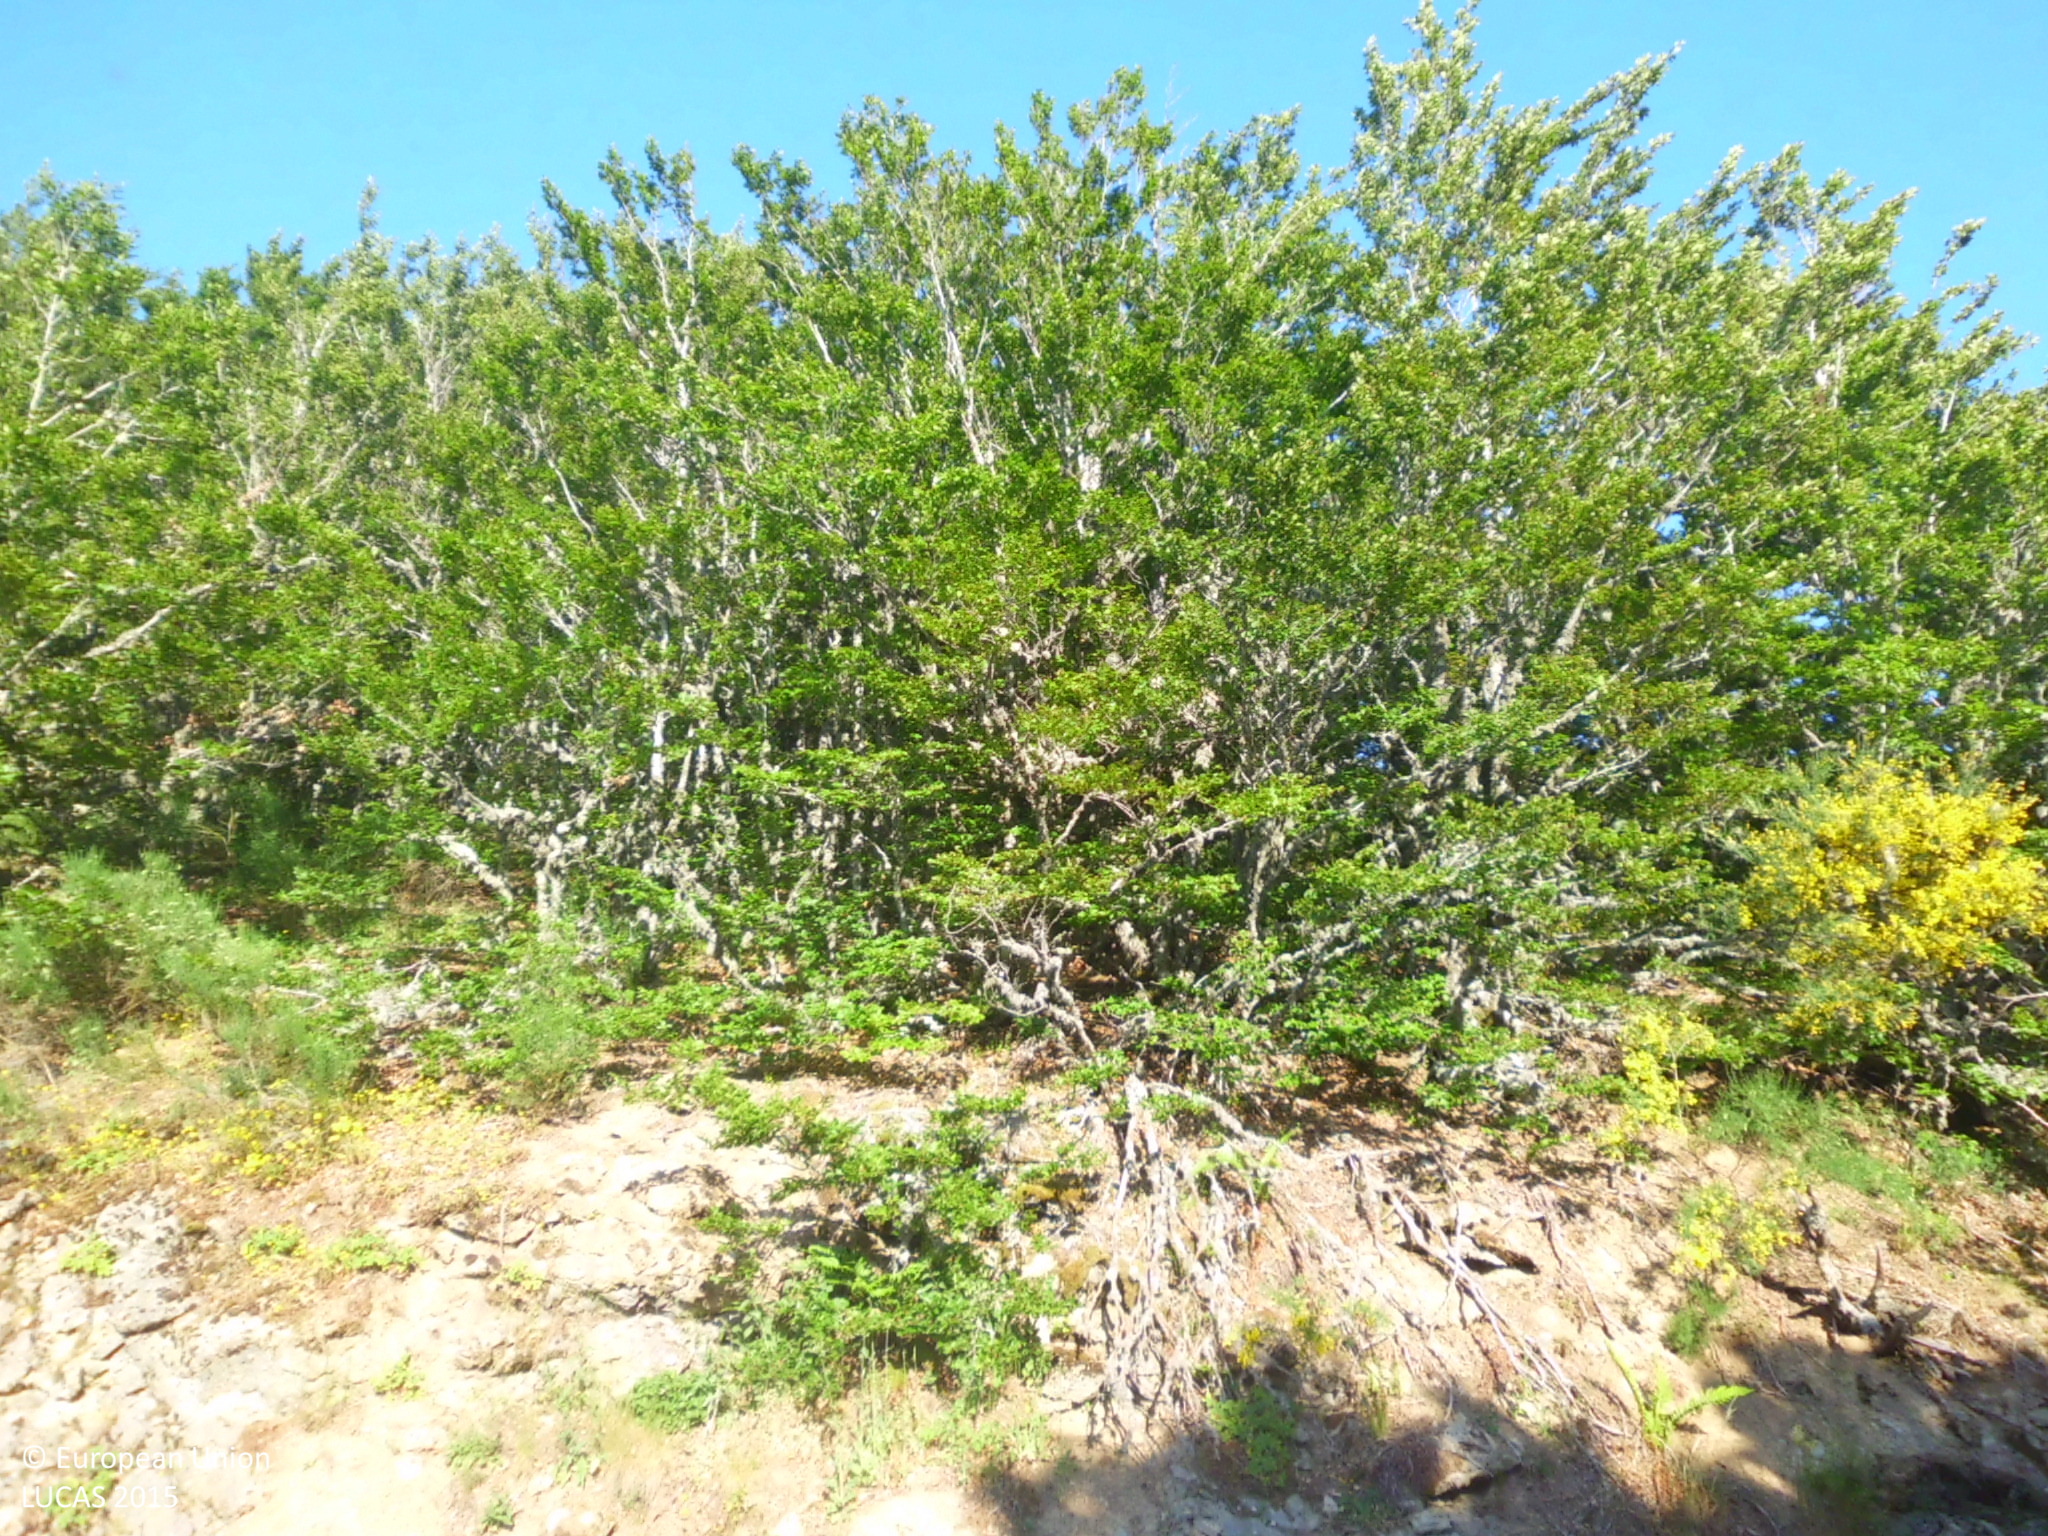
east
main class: Woodland
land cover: Broadleaved woodland
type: acidophilous oak and oak-birch forest
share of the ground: > 75 %
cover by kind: broadleaved forest trees 95 %, herbaceous plants 5 %
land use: Semi-natural and natural areas not in use
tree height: > 5 m
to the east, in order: Broadleaved woodland; Paved roads, cycling and walking lanes; Broadleaved woodland; Paved roads, cycling and walking lanes; Broadleaved woodland
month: June
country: ES
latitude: 42.9303
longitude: -4.9514
